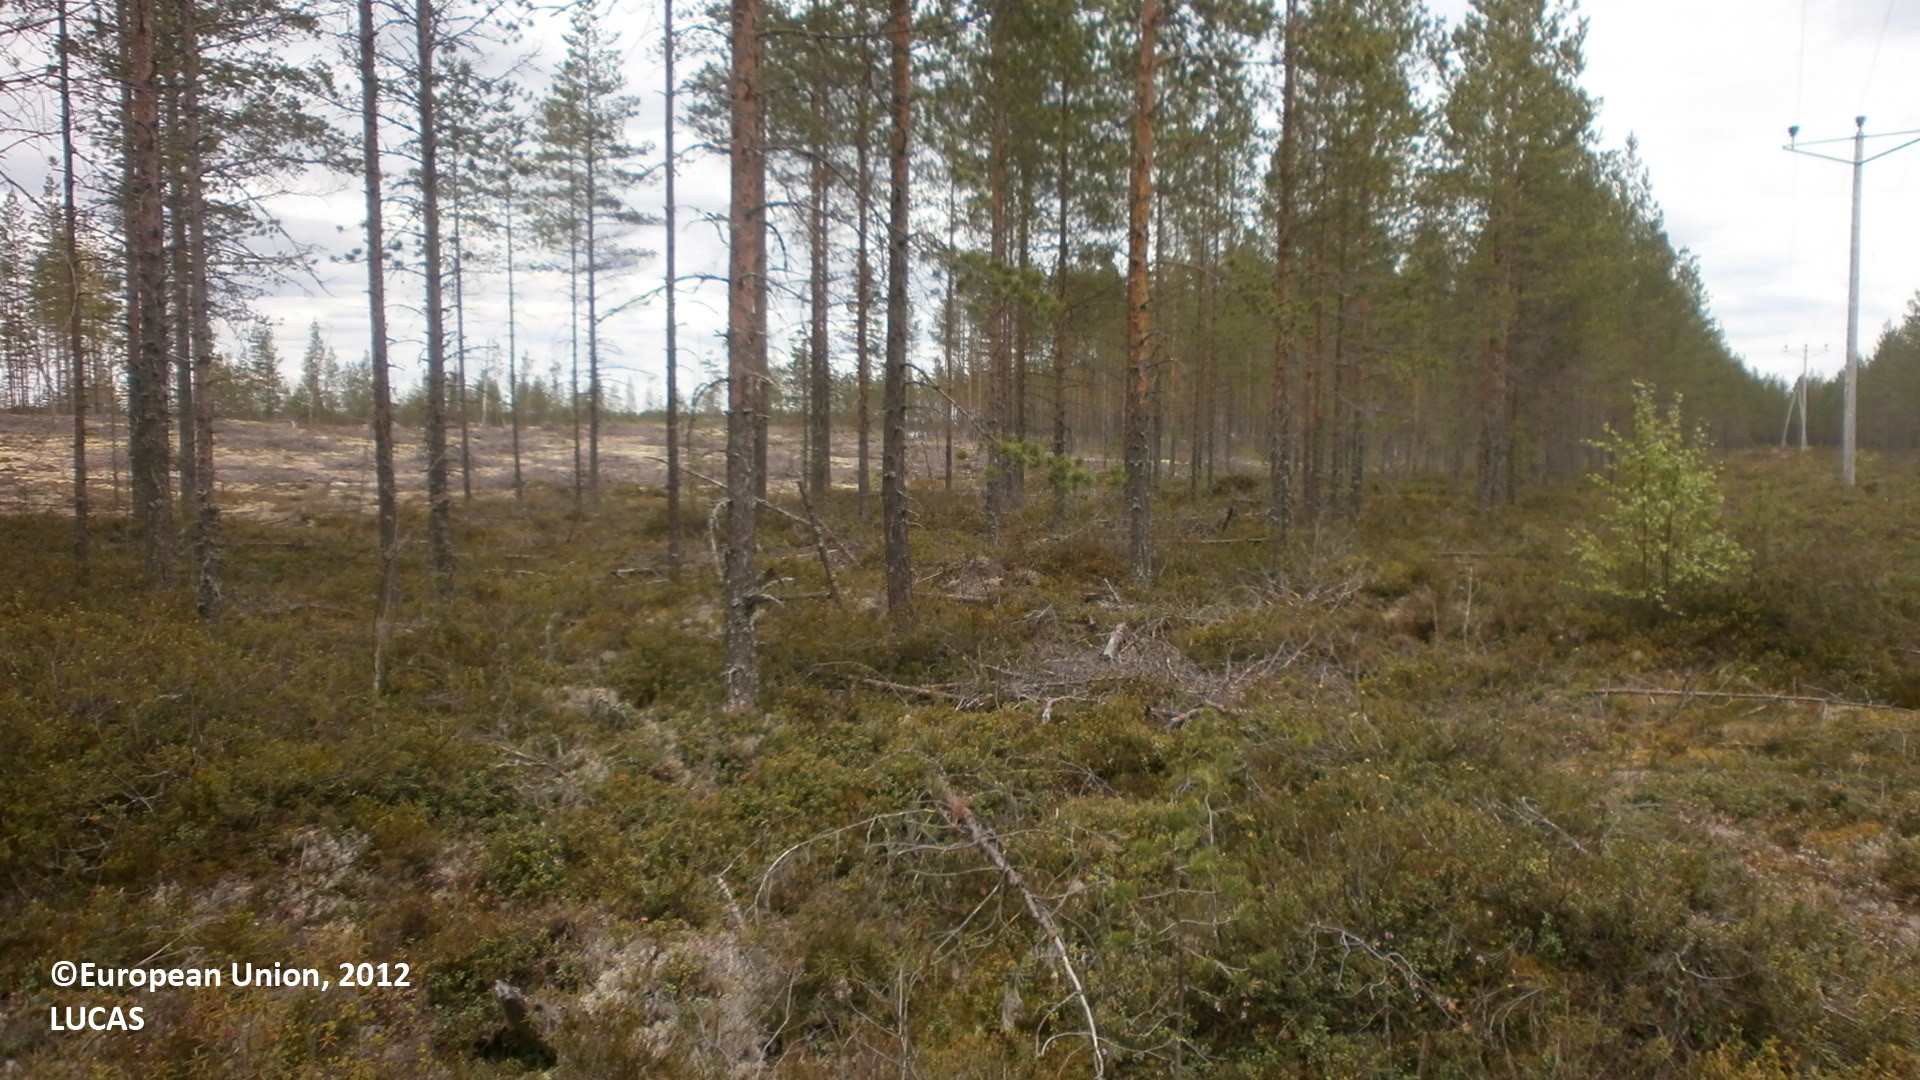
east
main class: Grassland
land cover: Spontaneously vegetated surfaces
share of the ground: > 75 %
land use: Energy production
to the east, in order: Spontaneously vegetated surfaces; Electric lines; Spontaneously vegetated surfaces; Pine dominated coniferous woodland; Spontaneously vegetated surfaces; Tracks; Spontaneously vegetated surfaces; Pine dominated coniferous woodland; Peatbogs
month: June
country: FI
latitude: 64.4487
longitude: 25.0631
